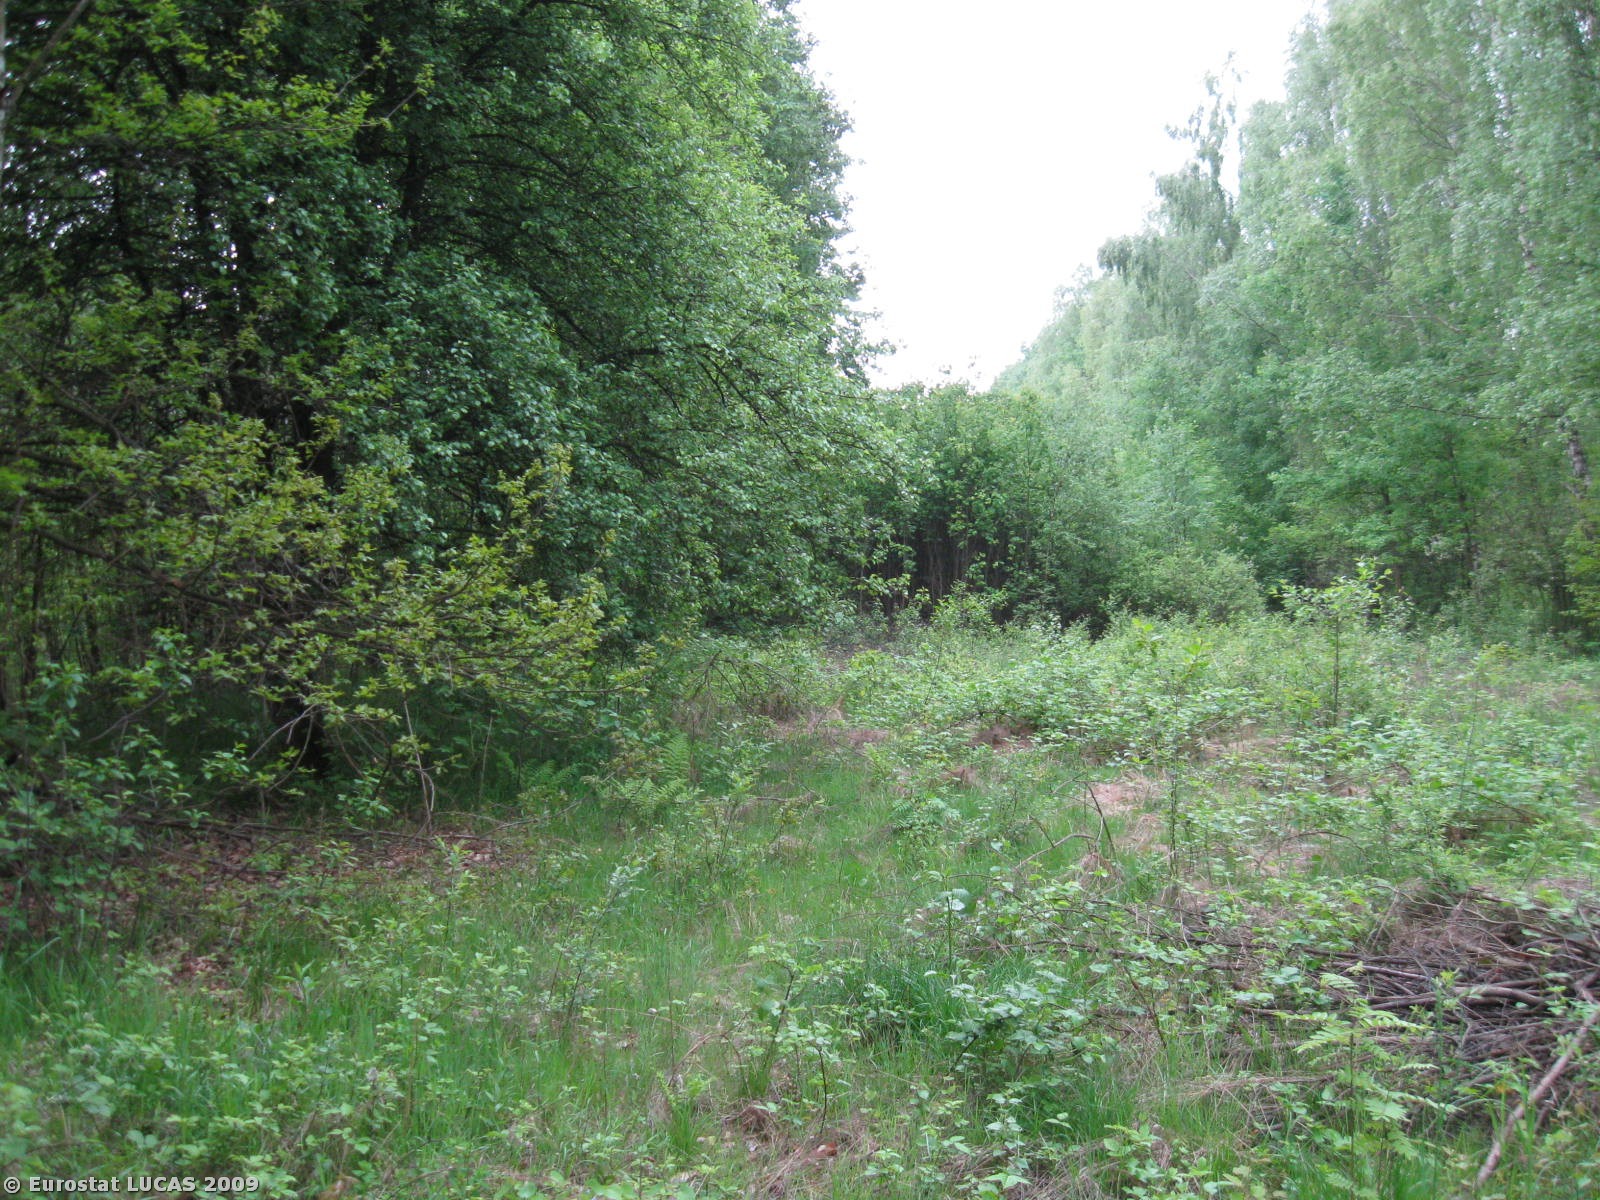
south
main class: Woodland
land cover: Broadleaved woodland
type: hemiboreal forest and nemoral coniferous forest and mixed broadleaved-coniferous forest
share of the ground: > 75 %
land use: Forestry
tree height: > 5 m
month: May
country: PL
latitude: 51.0052
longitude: 20.4843
